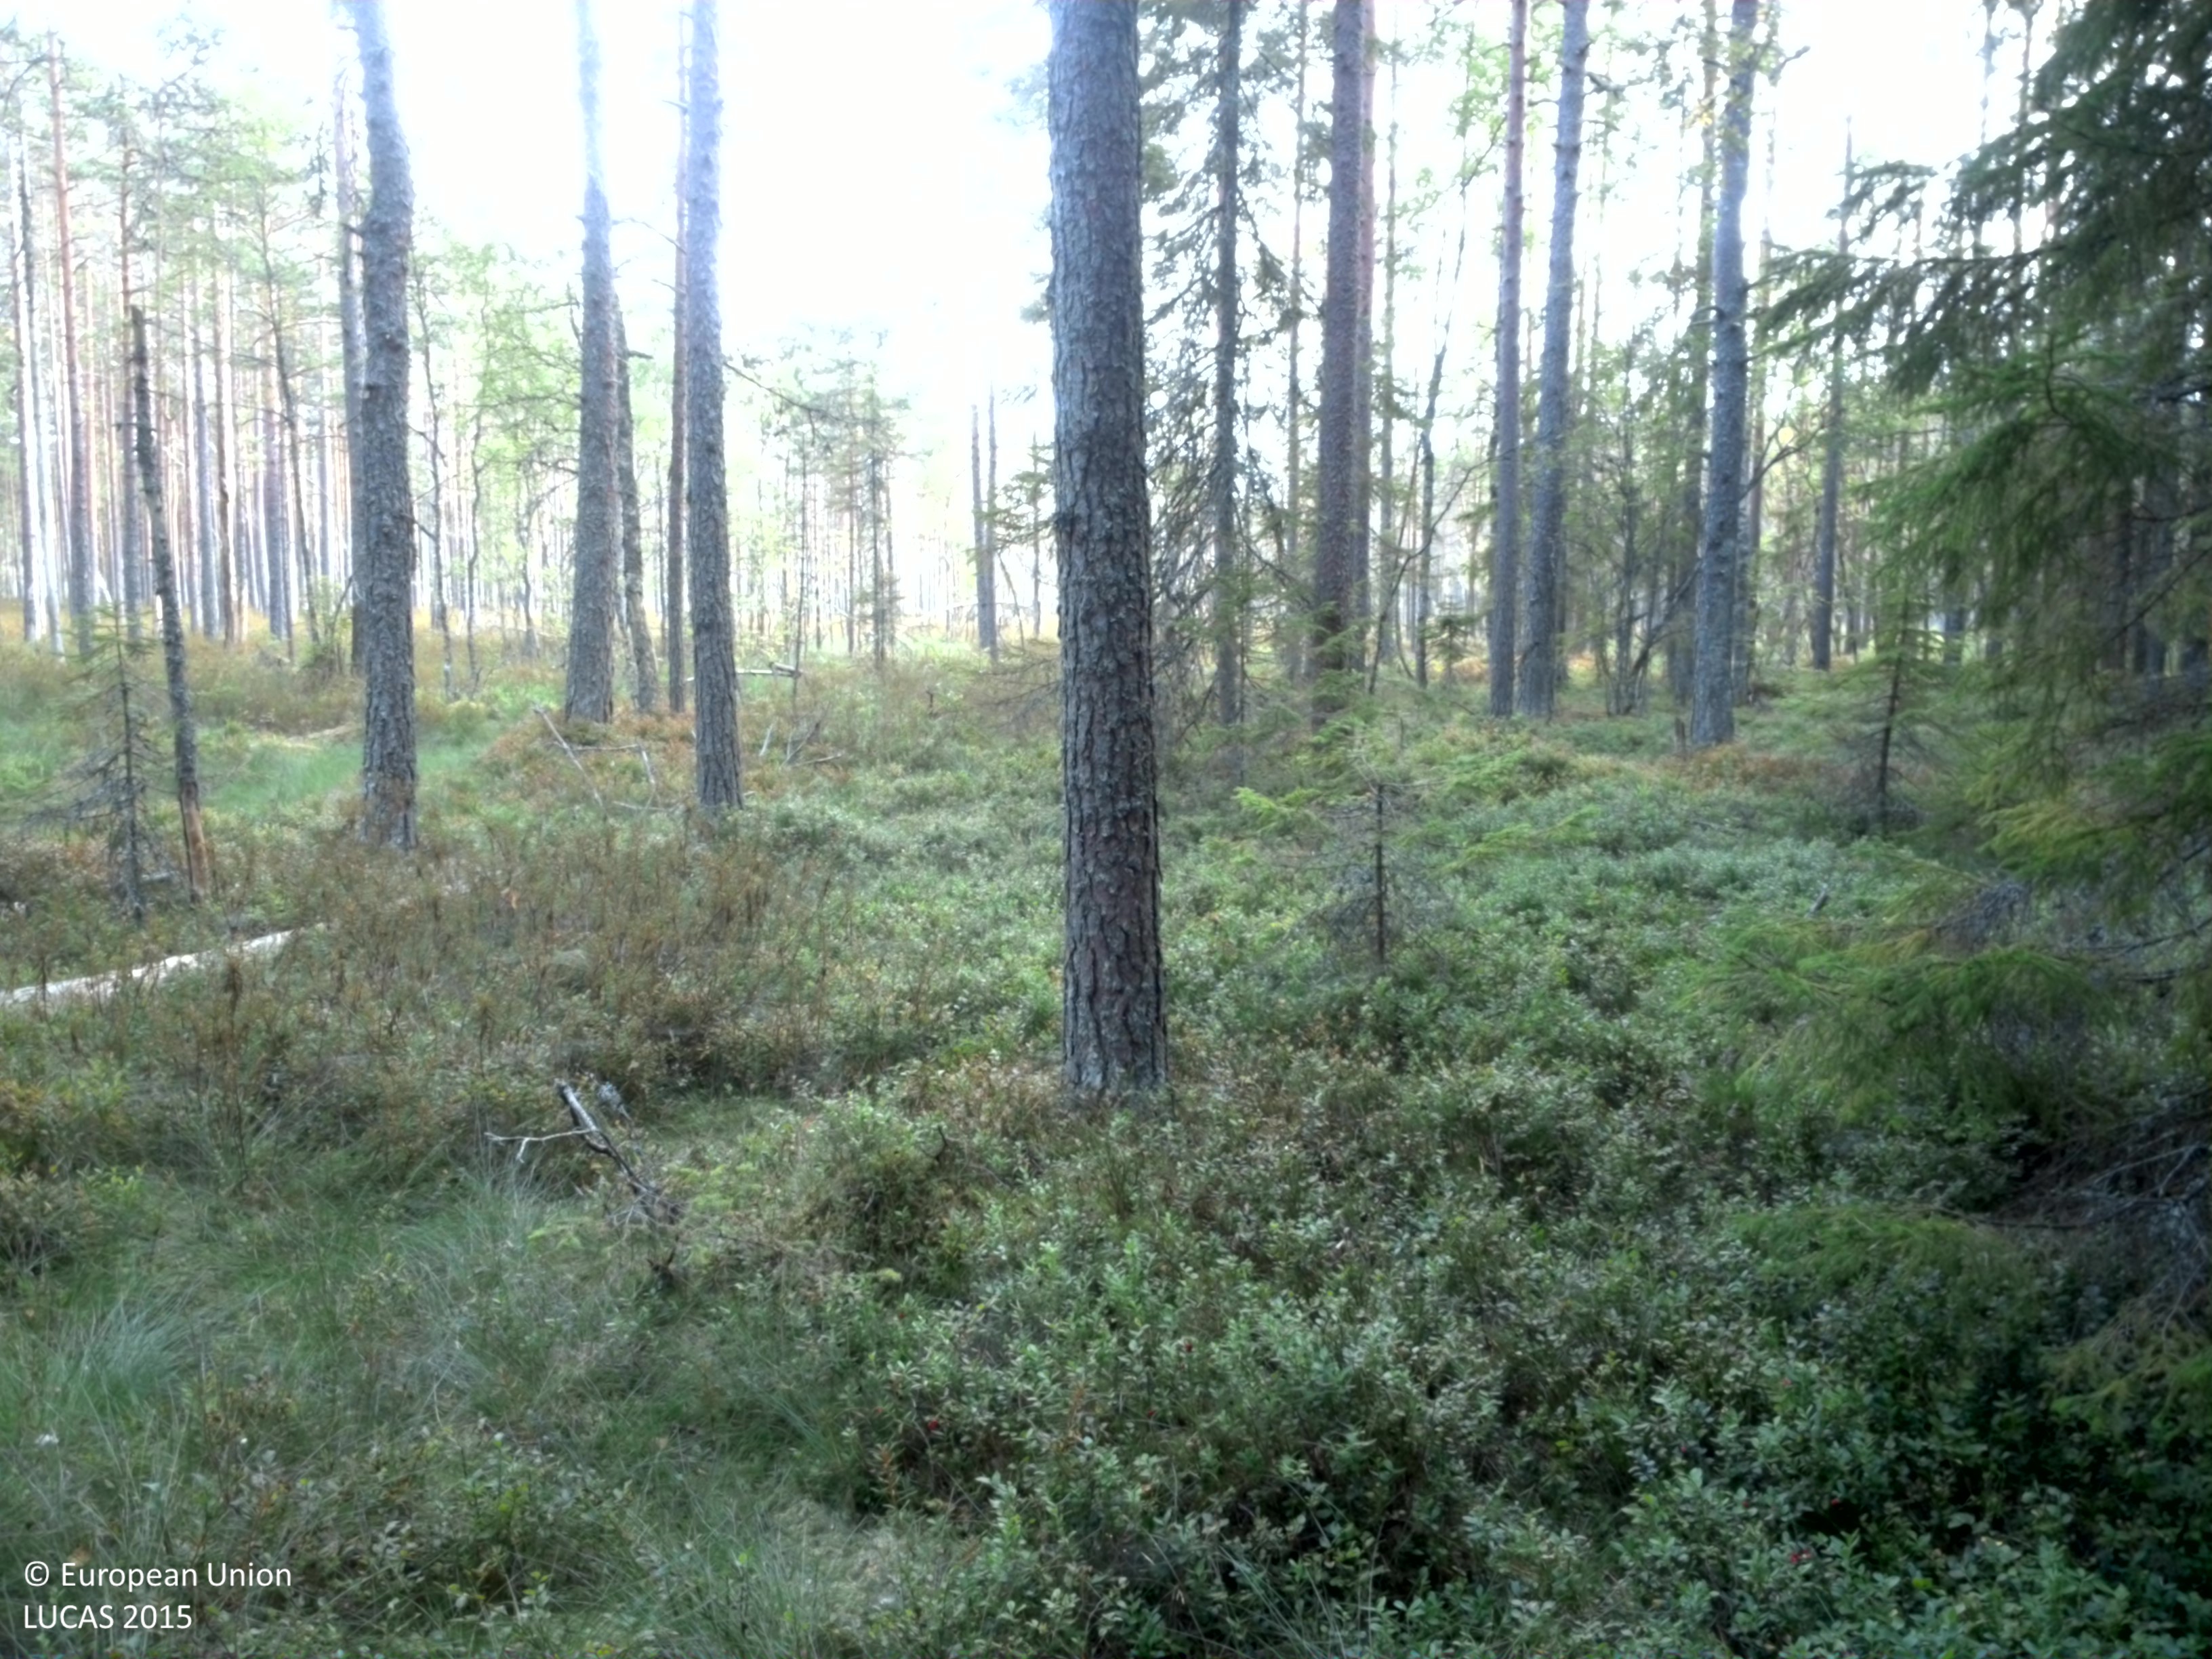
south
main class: Woodland
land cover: Other coniferous woodland
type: boreal forest
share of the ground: > 75 %
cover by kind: coniferous forest trees 60 %, broadleaved forest trees 15 %, shrubs 15 %, herbaceous plants 5 %, lichens and mosses 5 %
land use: Forestry
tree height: > 5 m
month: August
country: SE
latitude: 59.8466
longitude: 15.7549
